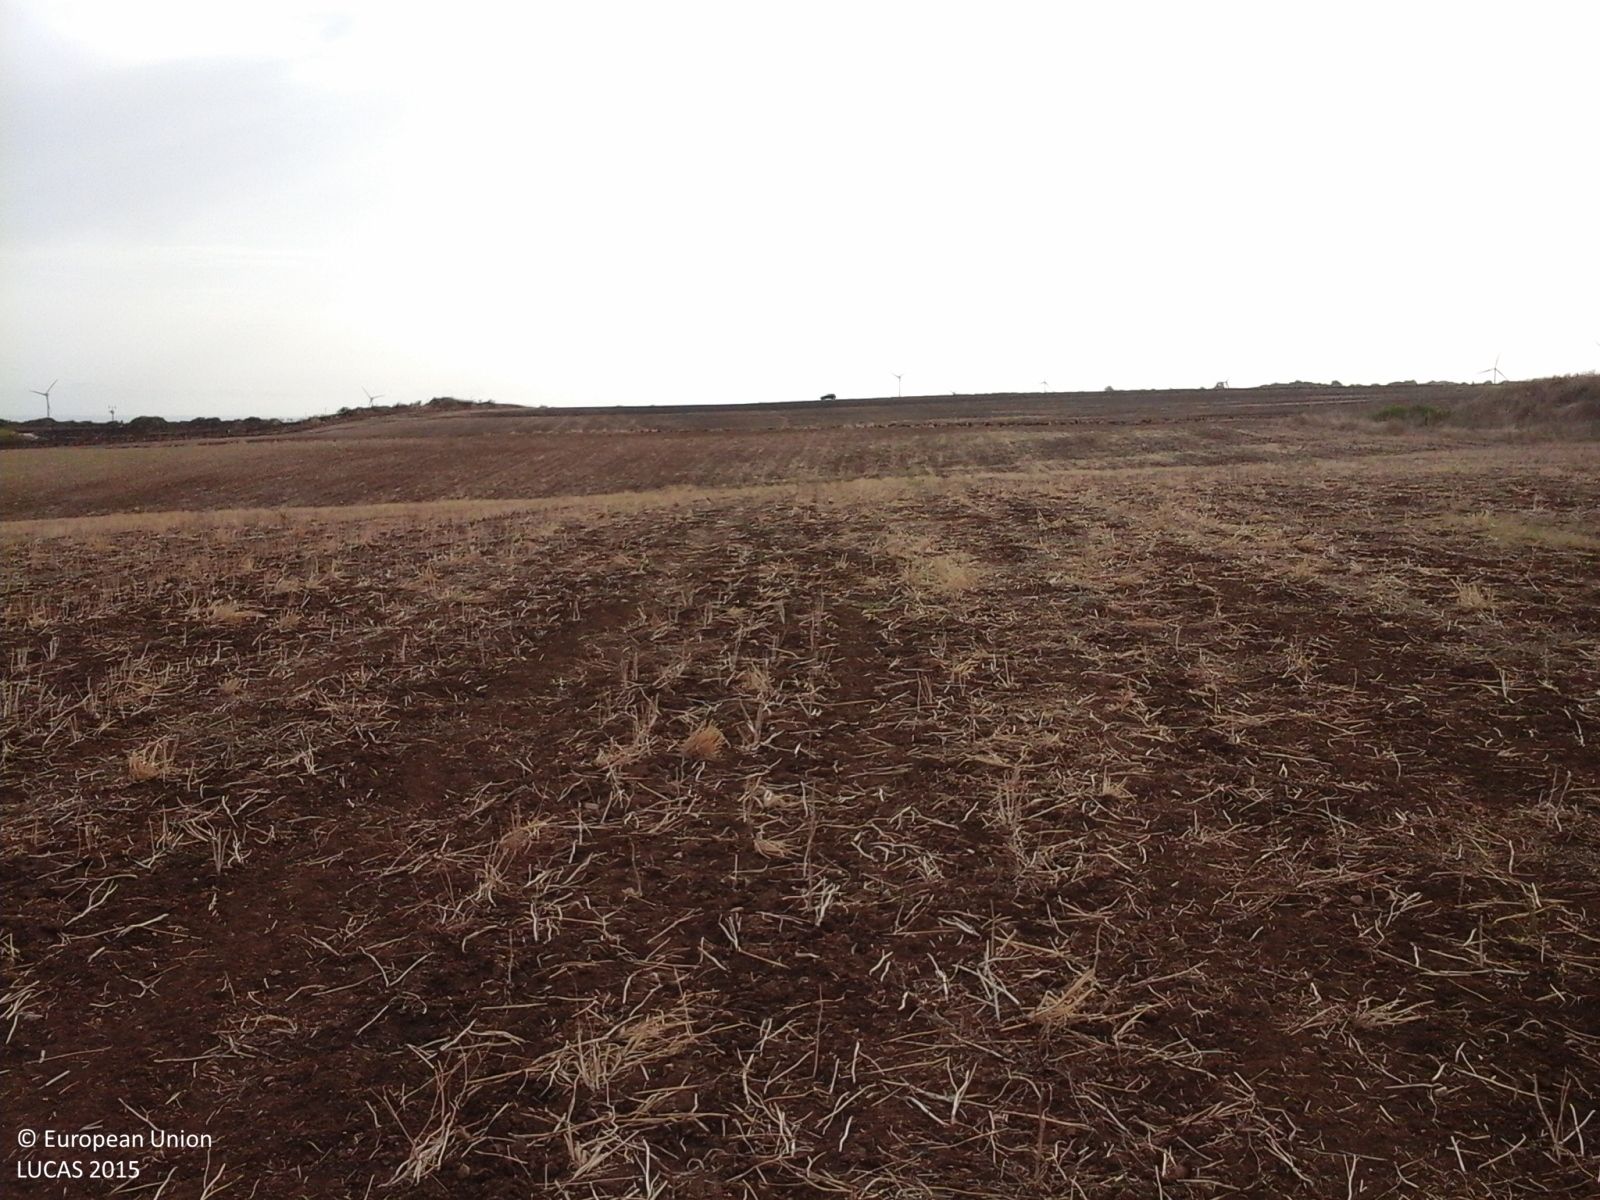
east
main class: Cropland
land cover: Other non-permanent industrial crops
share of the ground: > 75 %
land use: Agriculture (excluding fallow land and kitchen gardens)
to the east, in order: Other non-permanent industrial crops; Durum wheat
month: September
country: IT
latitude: 41.8881
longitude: 15.1784
